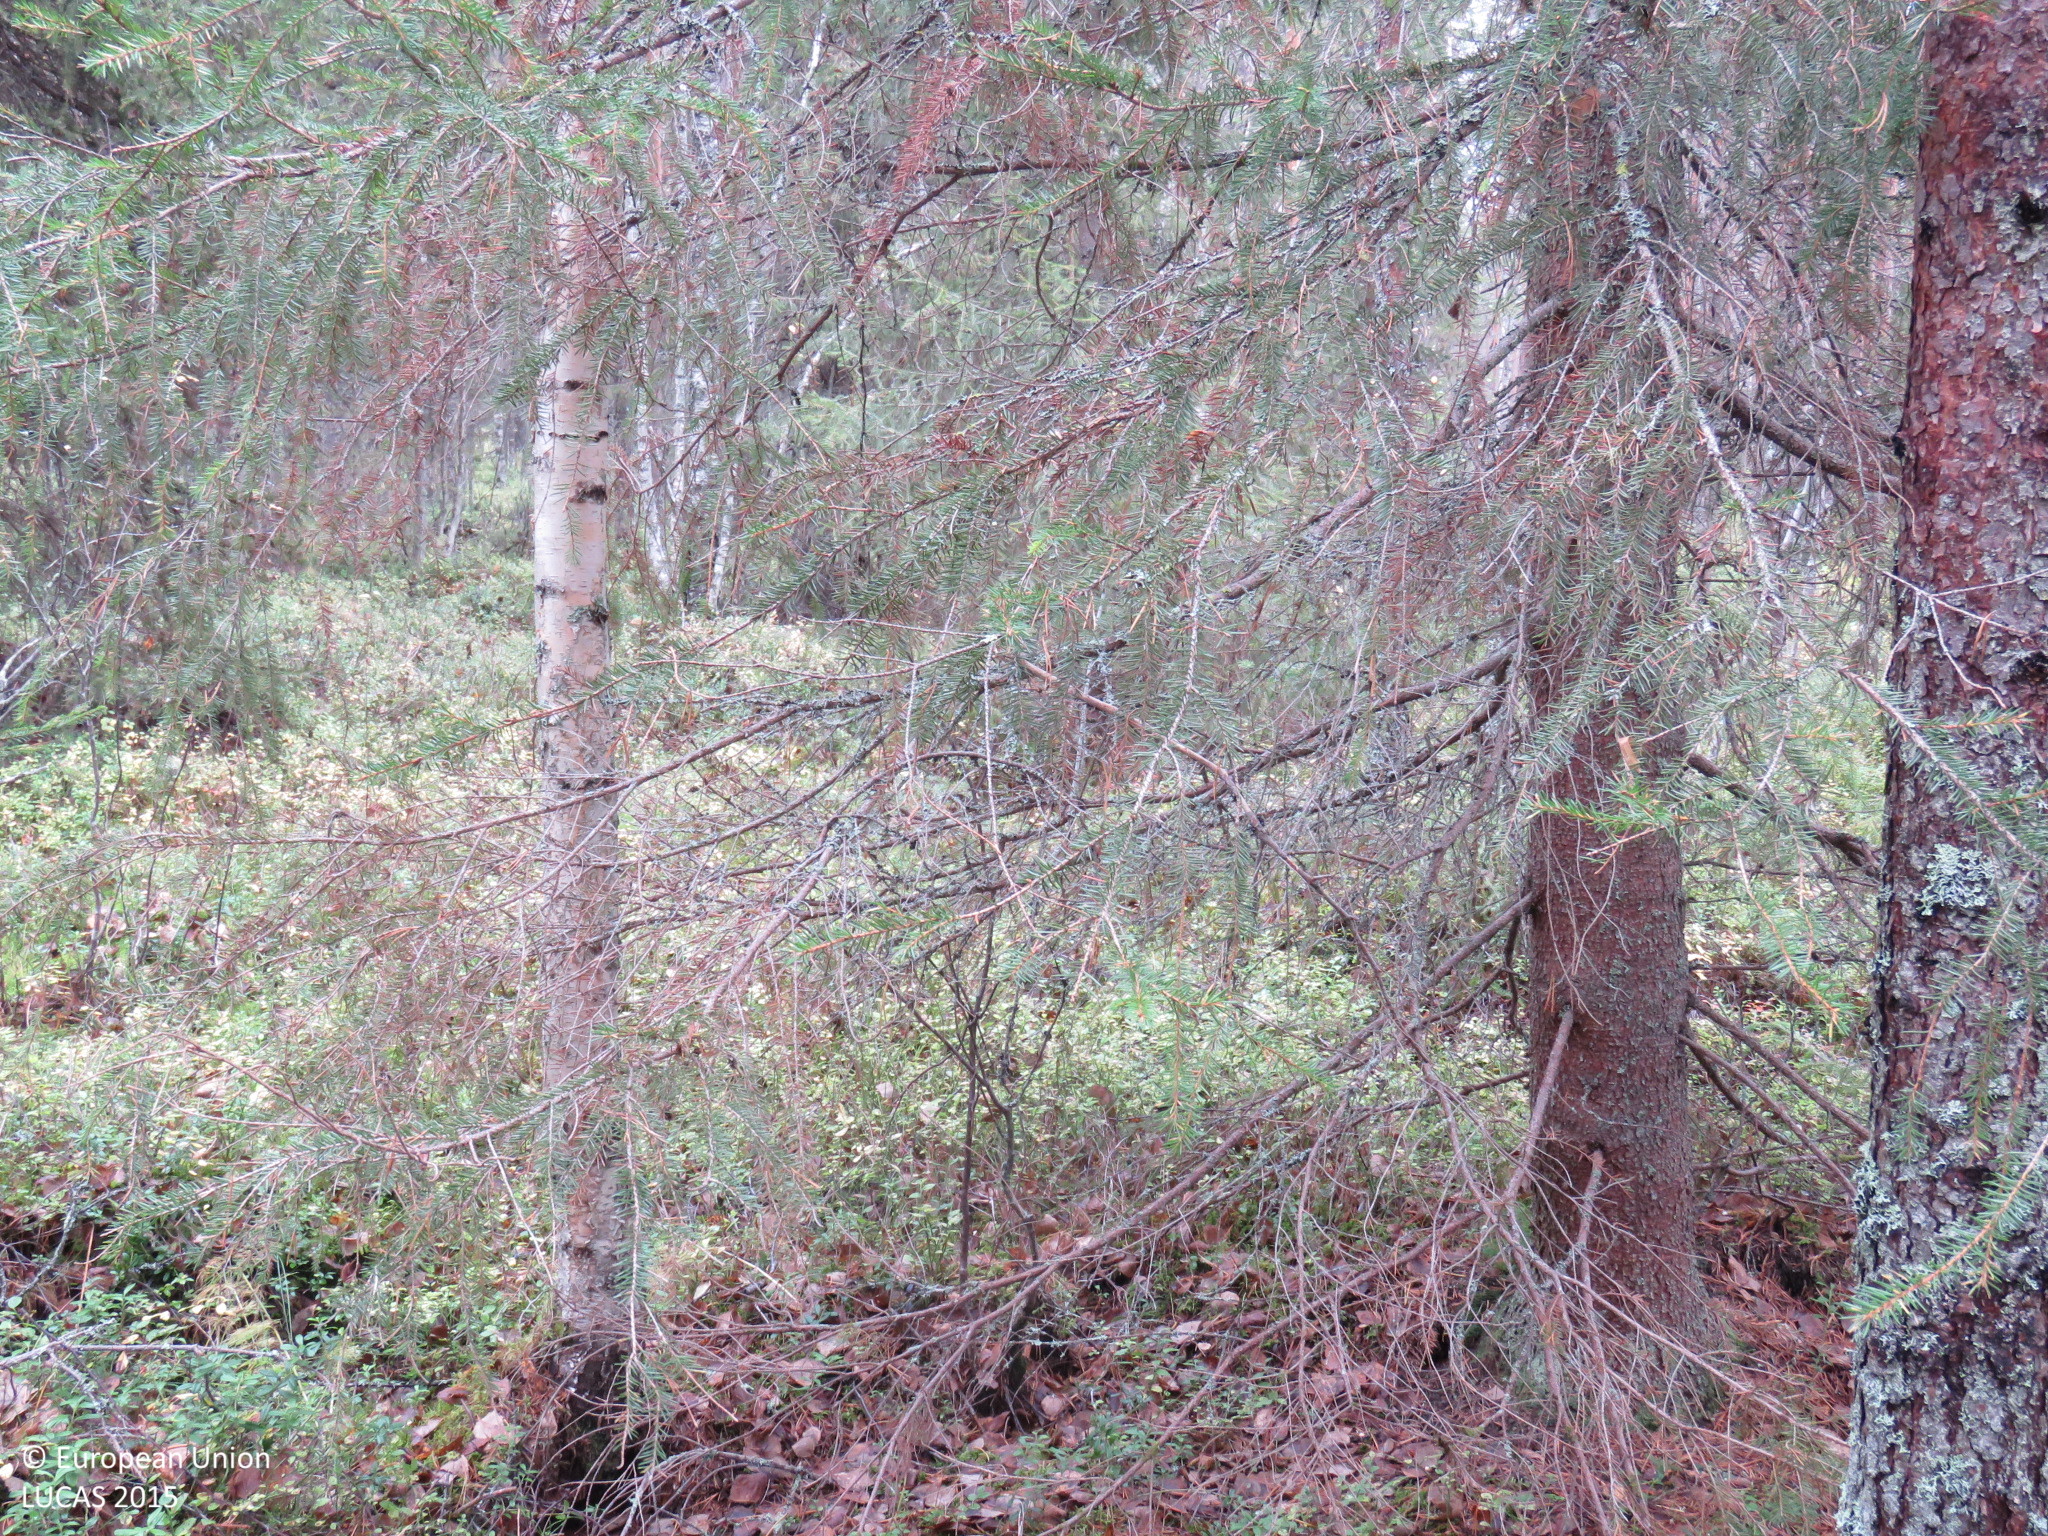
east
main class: Woodland
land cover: Other coniferous woodland
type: boreal forest
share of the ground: > 75 %
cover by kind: coniferous forest trees 70 %, shrubs 15 %, broadleaved forest trees 10 %, lichens and mosses 5 %
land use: Forestry
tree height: > 5 m
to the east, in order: Other coniferous woodland; Other mixed woodland; Pine dominated mixed woodland; Other coniferous woodland
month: September
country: FI
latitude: 64.9528
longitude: 27.0377
